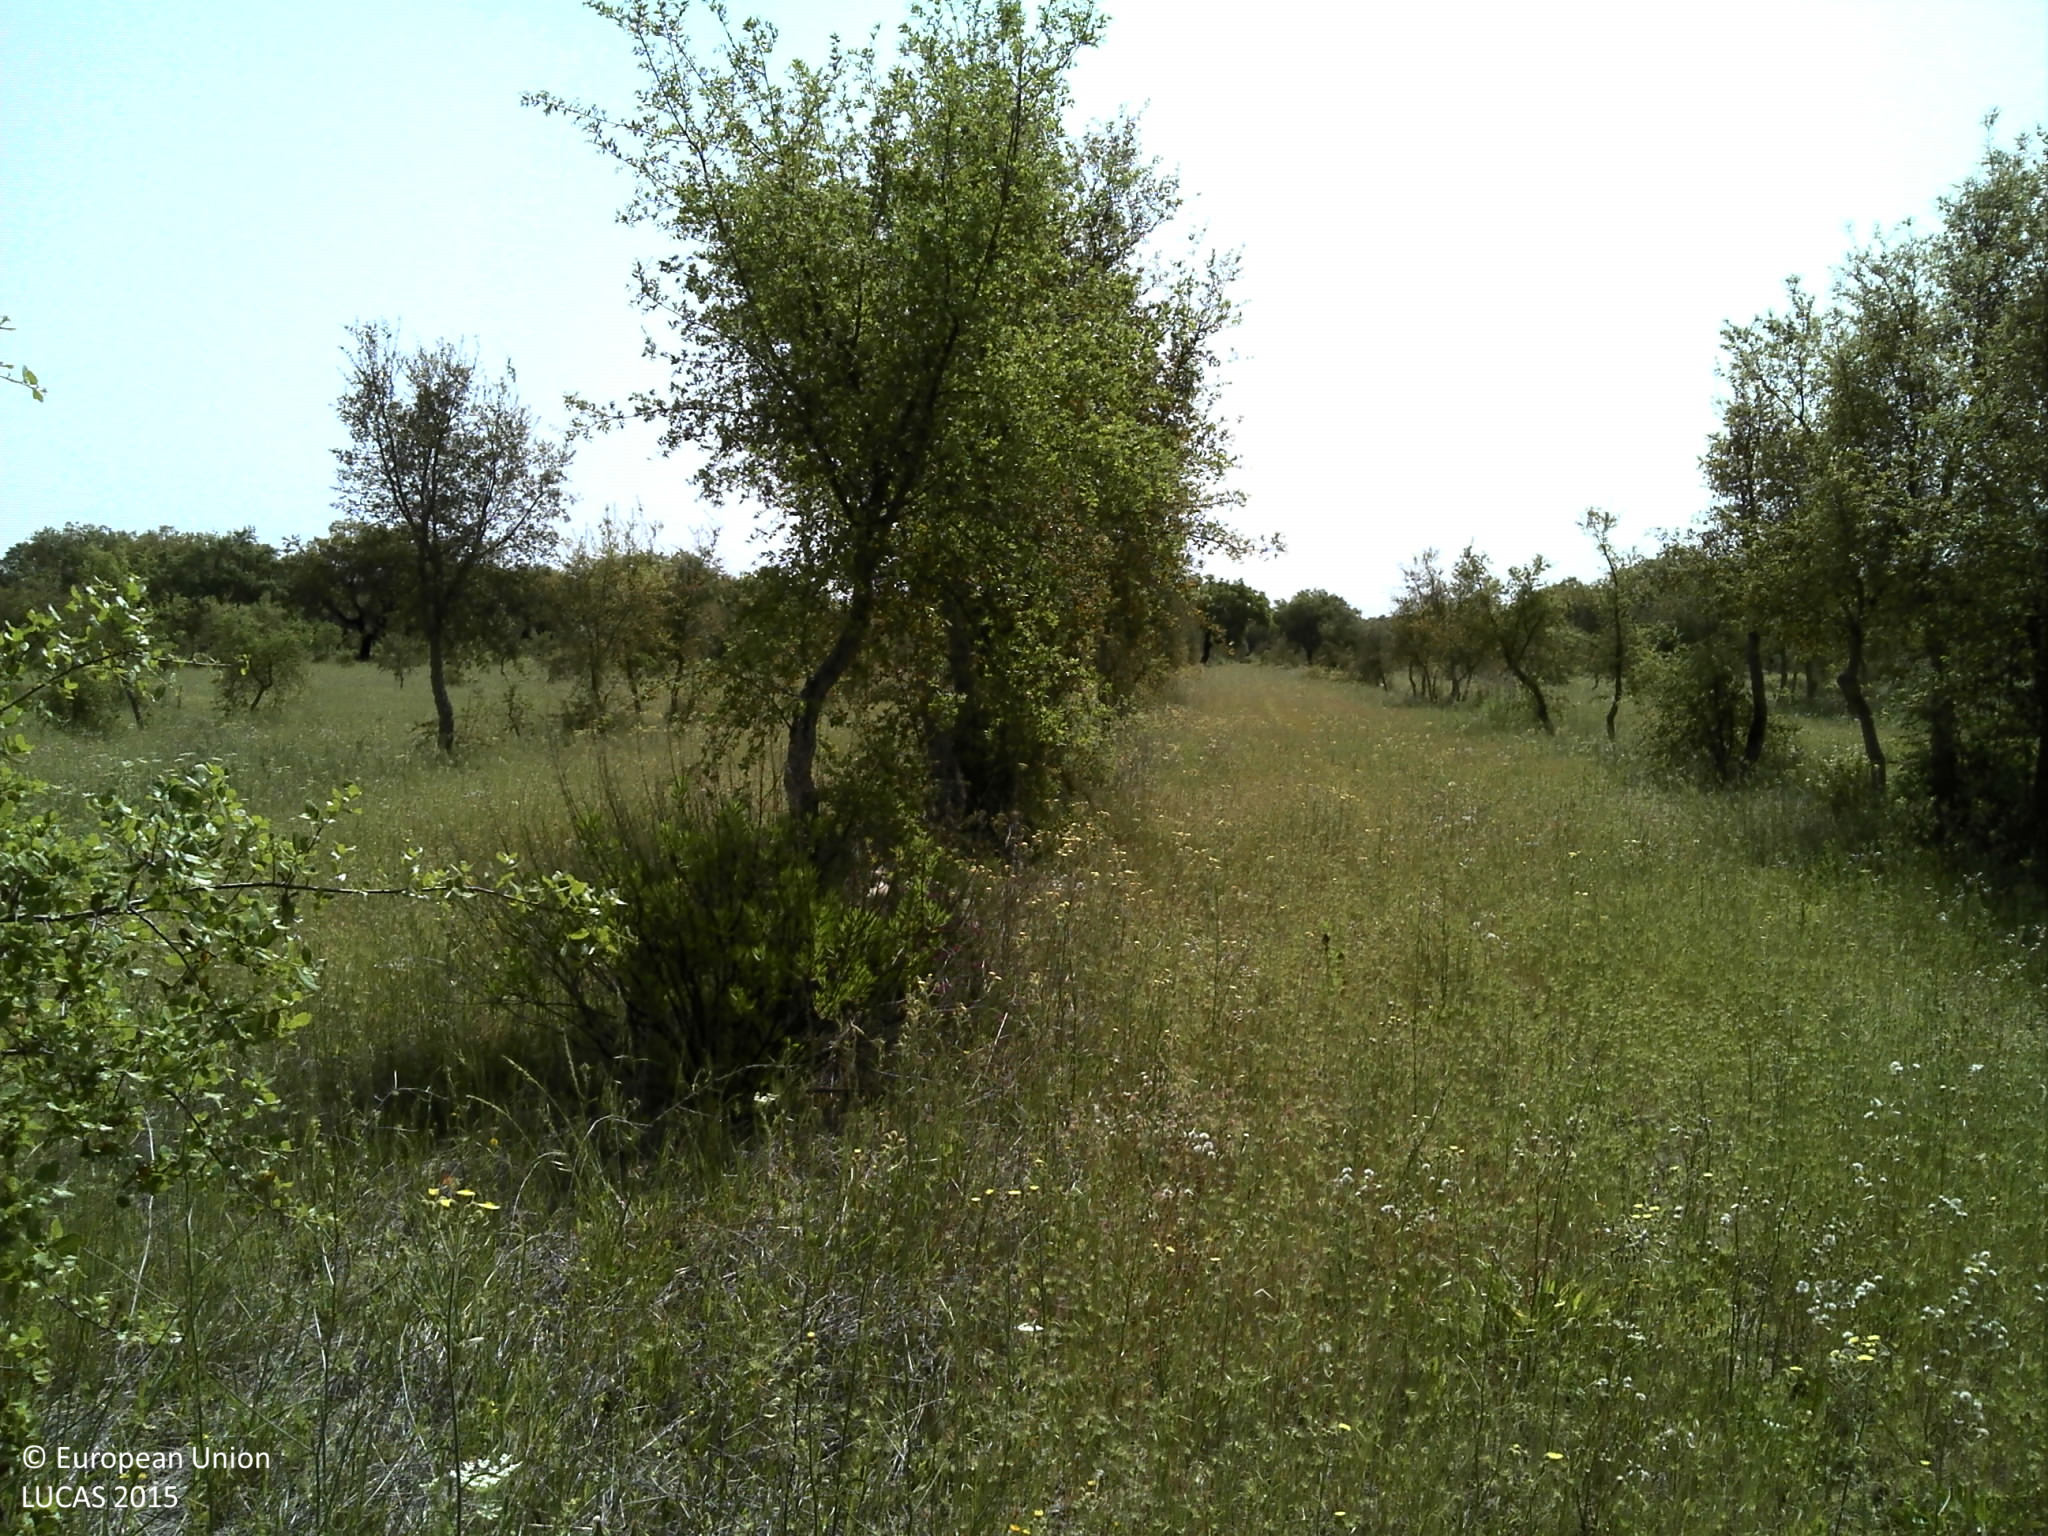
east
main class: Woodland
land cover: Broadleaved woodland
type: broadleaved evergreen forest
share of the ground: 10 - 25 %
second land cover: Grassland without tree/shrub cover
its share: 25 - 50 %
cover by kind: herbaceous plants 40 %, unconsolidated bare surface 40 %, broadleaved forest trees 20 %
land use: Forestry
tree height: < 5 m
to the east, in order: Broadleaved woodland; Grassland without tree/shrub cover; Broadleaved woodland; Electric lines; Broadleaved woodland
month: May
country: PT
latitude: 38.9566
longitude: -7.8038
